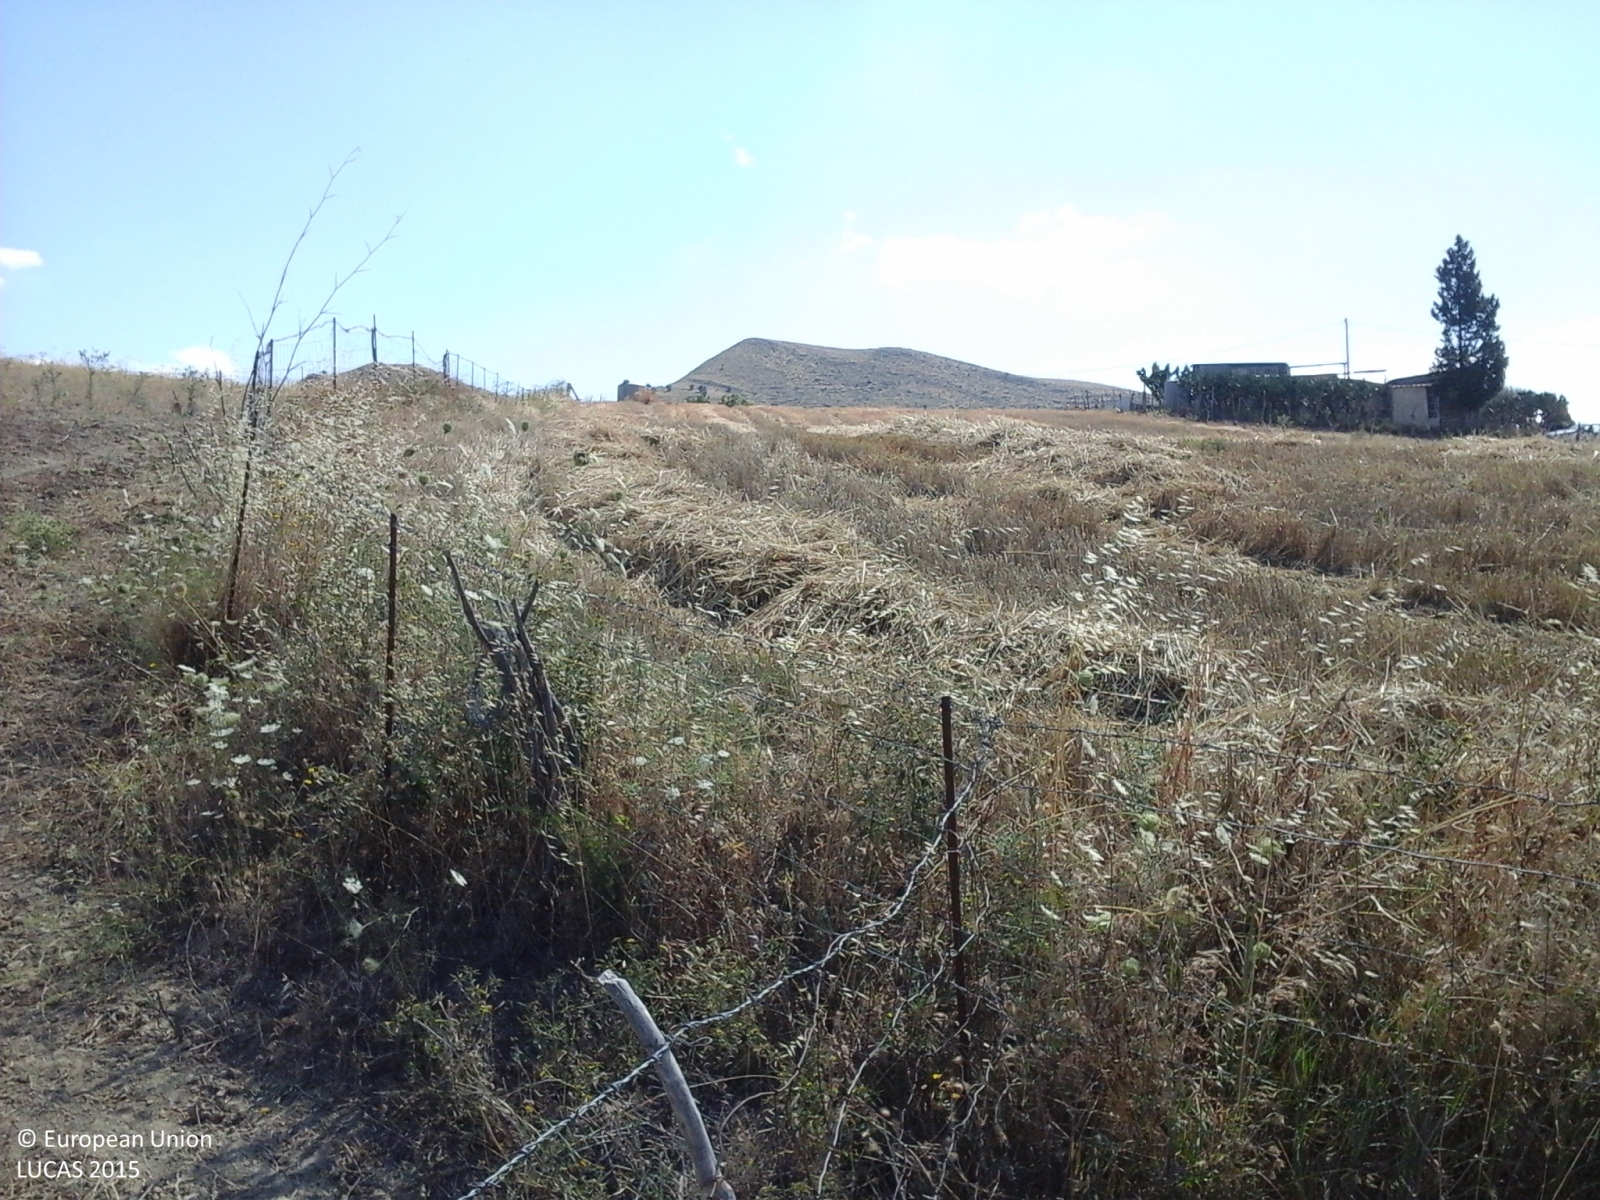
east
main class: Grassland
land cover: Spontaneously vegetated surfaces
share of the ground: > 75 %
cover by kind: herbaceous plants 75 %, unconsolidated bare surface 25 %
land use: Fallow land
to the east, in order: Spontaneously vegetated surfaces; Shrubland with sparse tree cover; Ditches and canals; Shrubland with sparse tree cover; Other bare soil; Shrubland with sparse tree cover; Ditches and canals; Shrubland with sparse tree cover; Other leguminous and mixtures for fodder
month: June
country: IT
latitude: 37.6372
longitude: 14.5793
